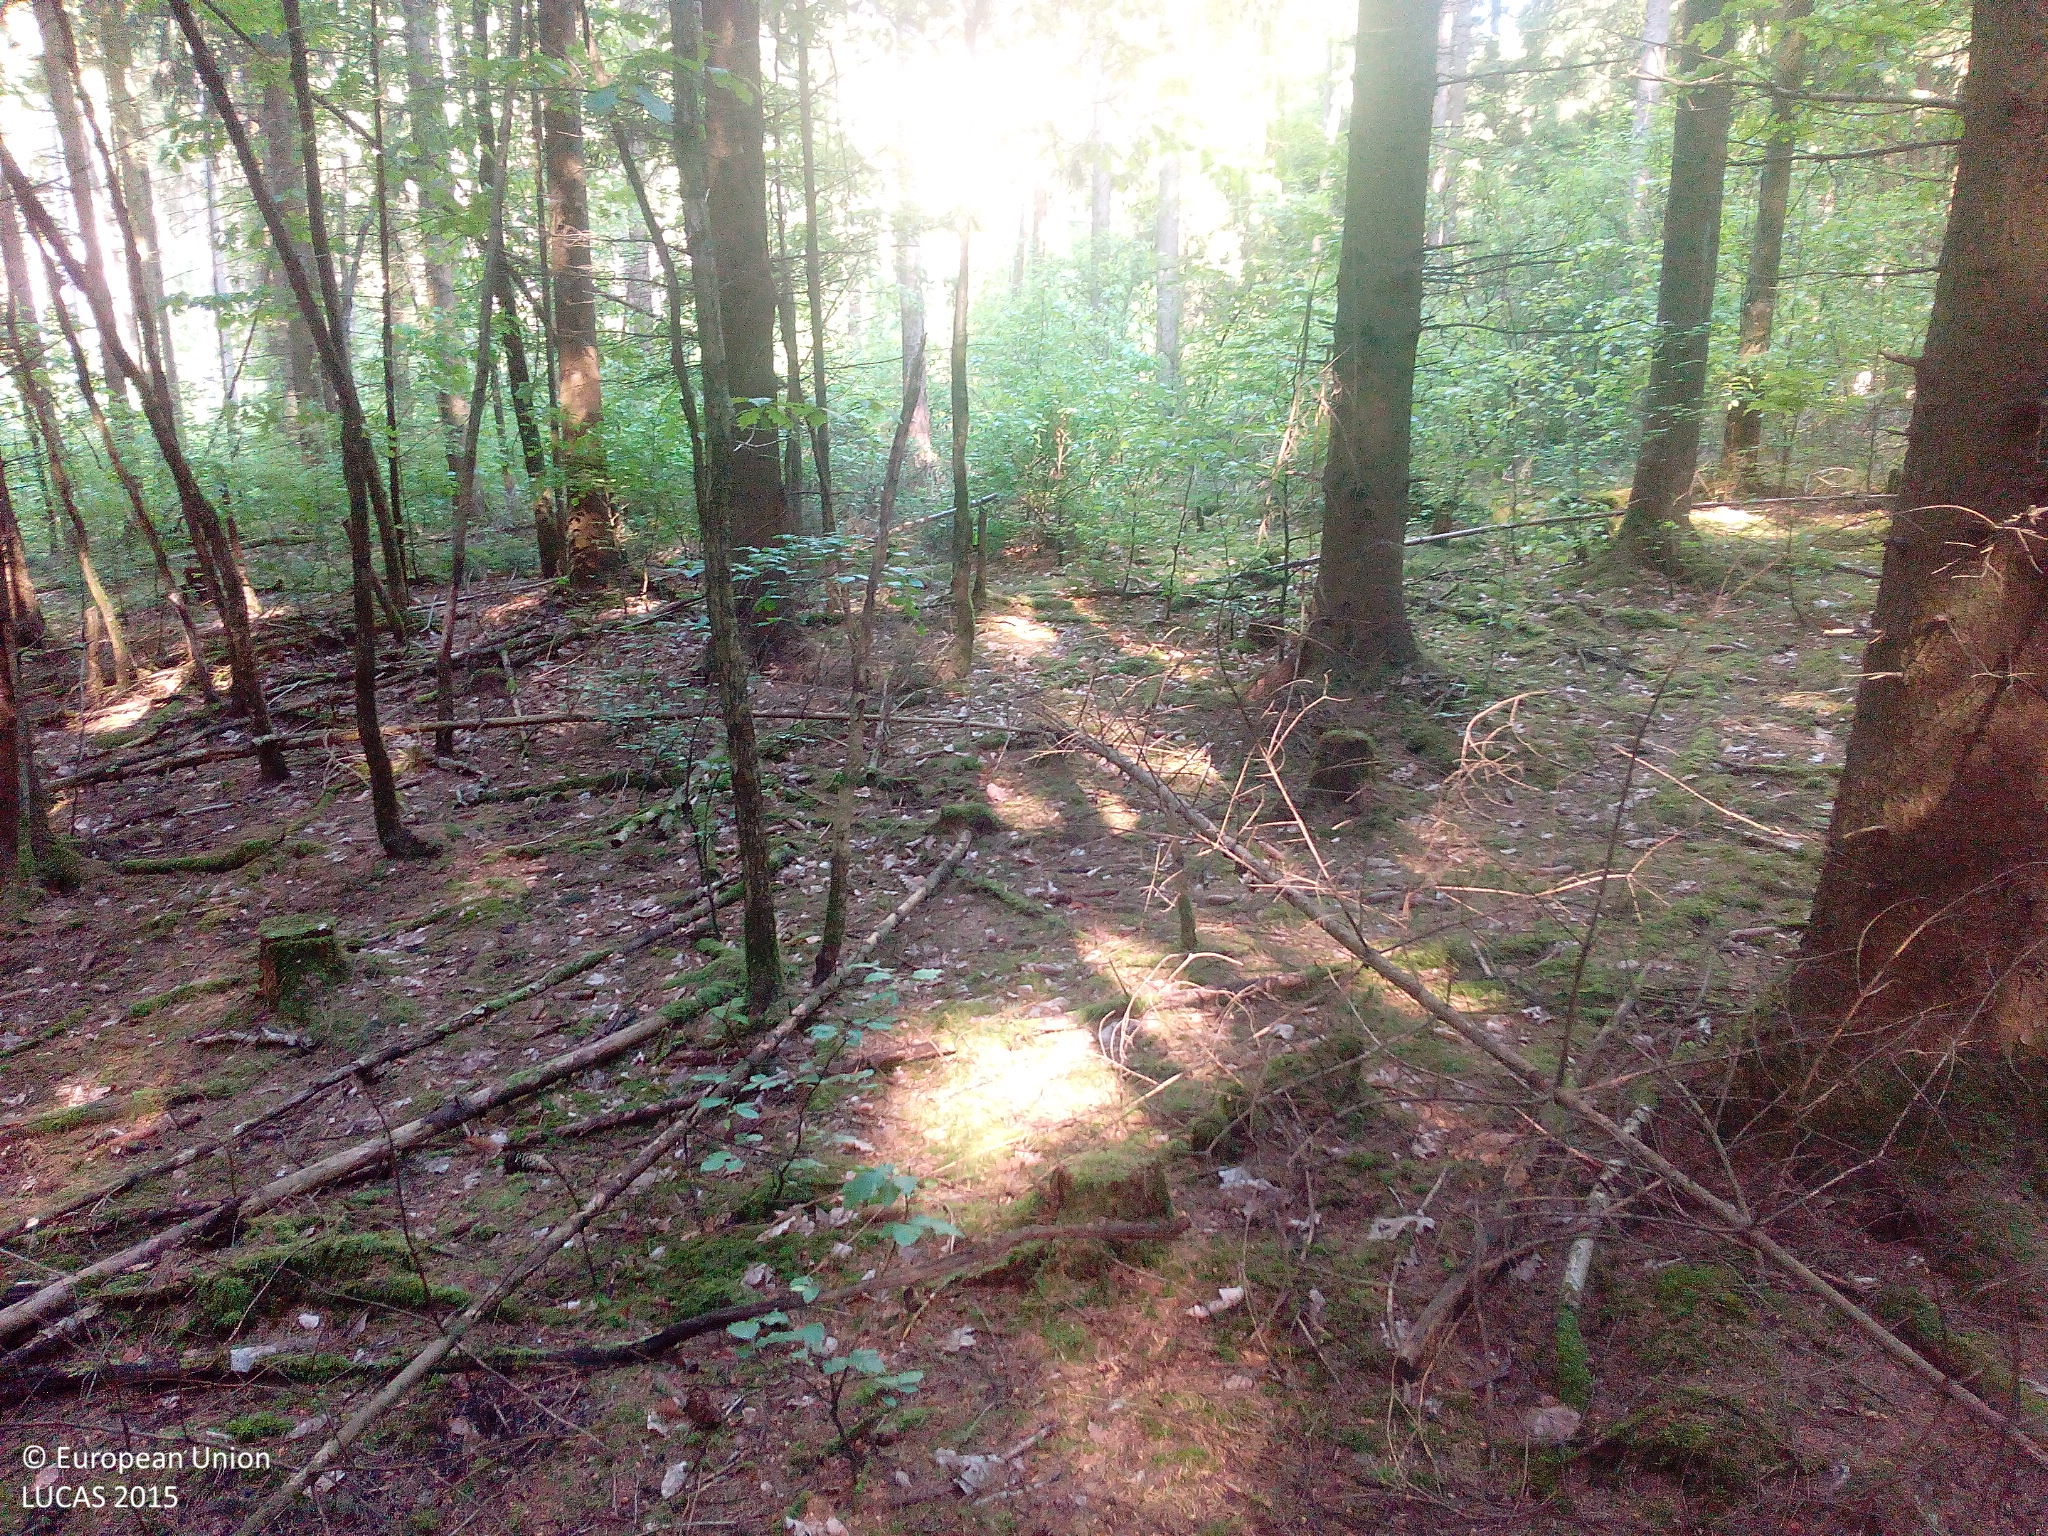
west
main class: Woodland
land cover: Spruce dominated coniferous woodland
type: hemiboreal forest and nemoral coniferous forest and mixed broadleaved-coniferous forest
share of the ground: > 75 %
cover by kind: coniferous forest trees 100 %
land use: Forestry
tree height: > 5 m
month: May
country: DE
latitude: 49.9826
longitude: 10.9341
